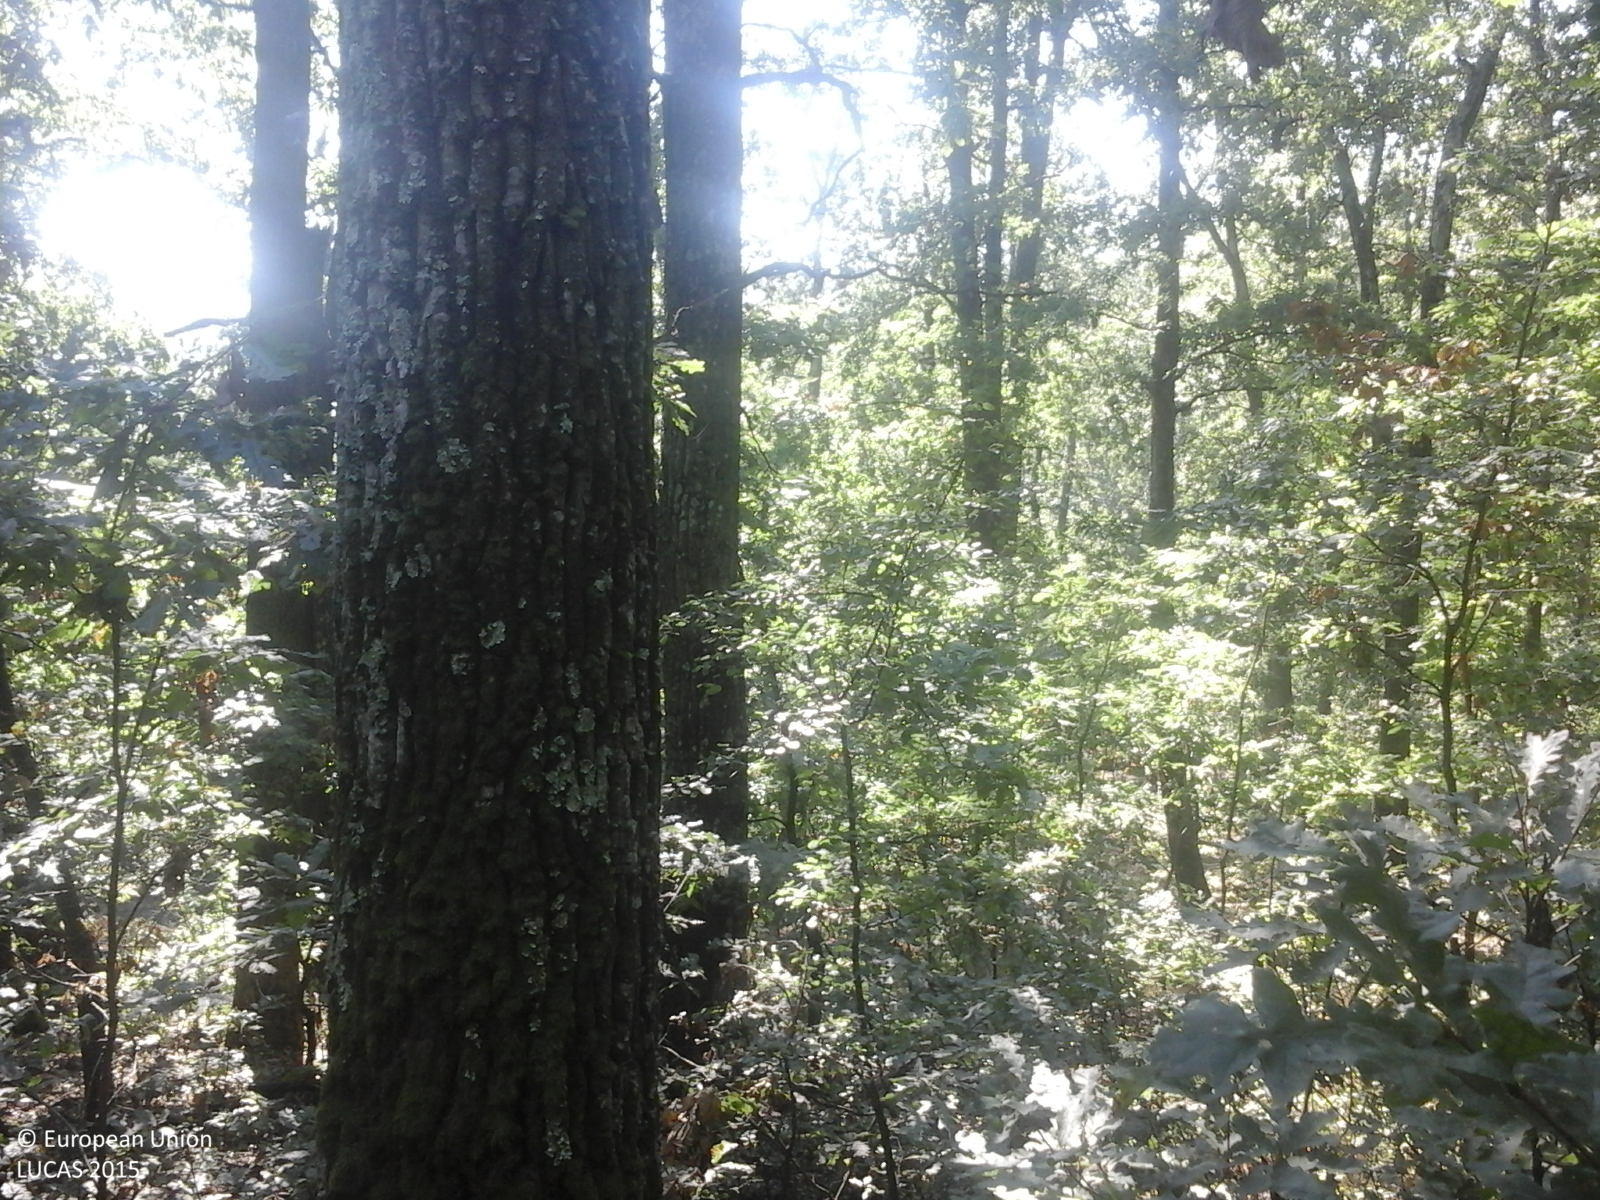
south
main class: Woodland
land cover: Broadleaved woodland
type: acidophilous oak and oak-birch forest
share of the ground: > 75 %
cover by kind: broadleaved forest trees 100 %
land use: Forestry
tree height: > 5 m
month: September
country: RO
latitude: 47.3930
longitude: 22.7120
